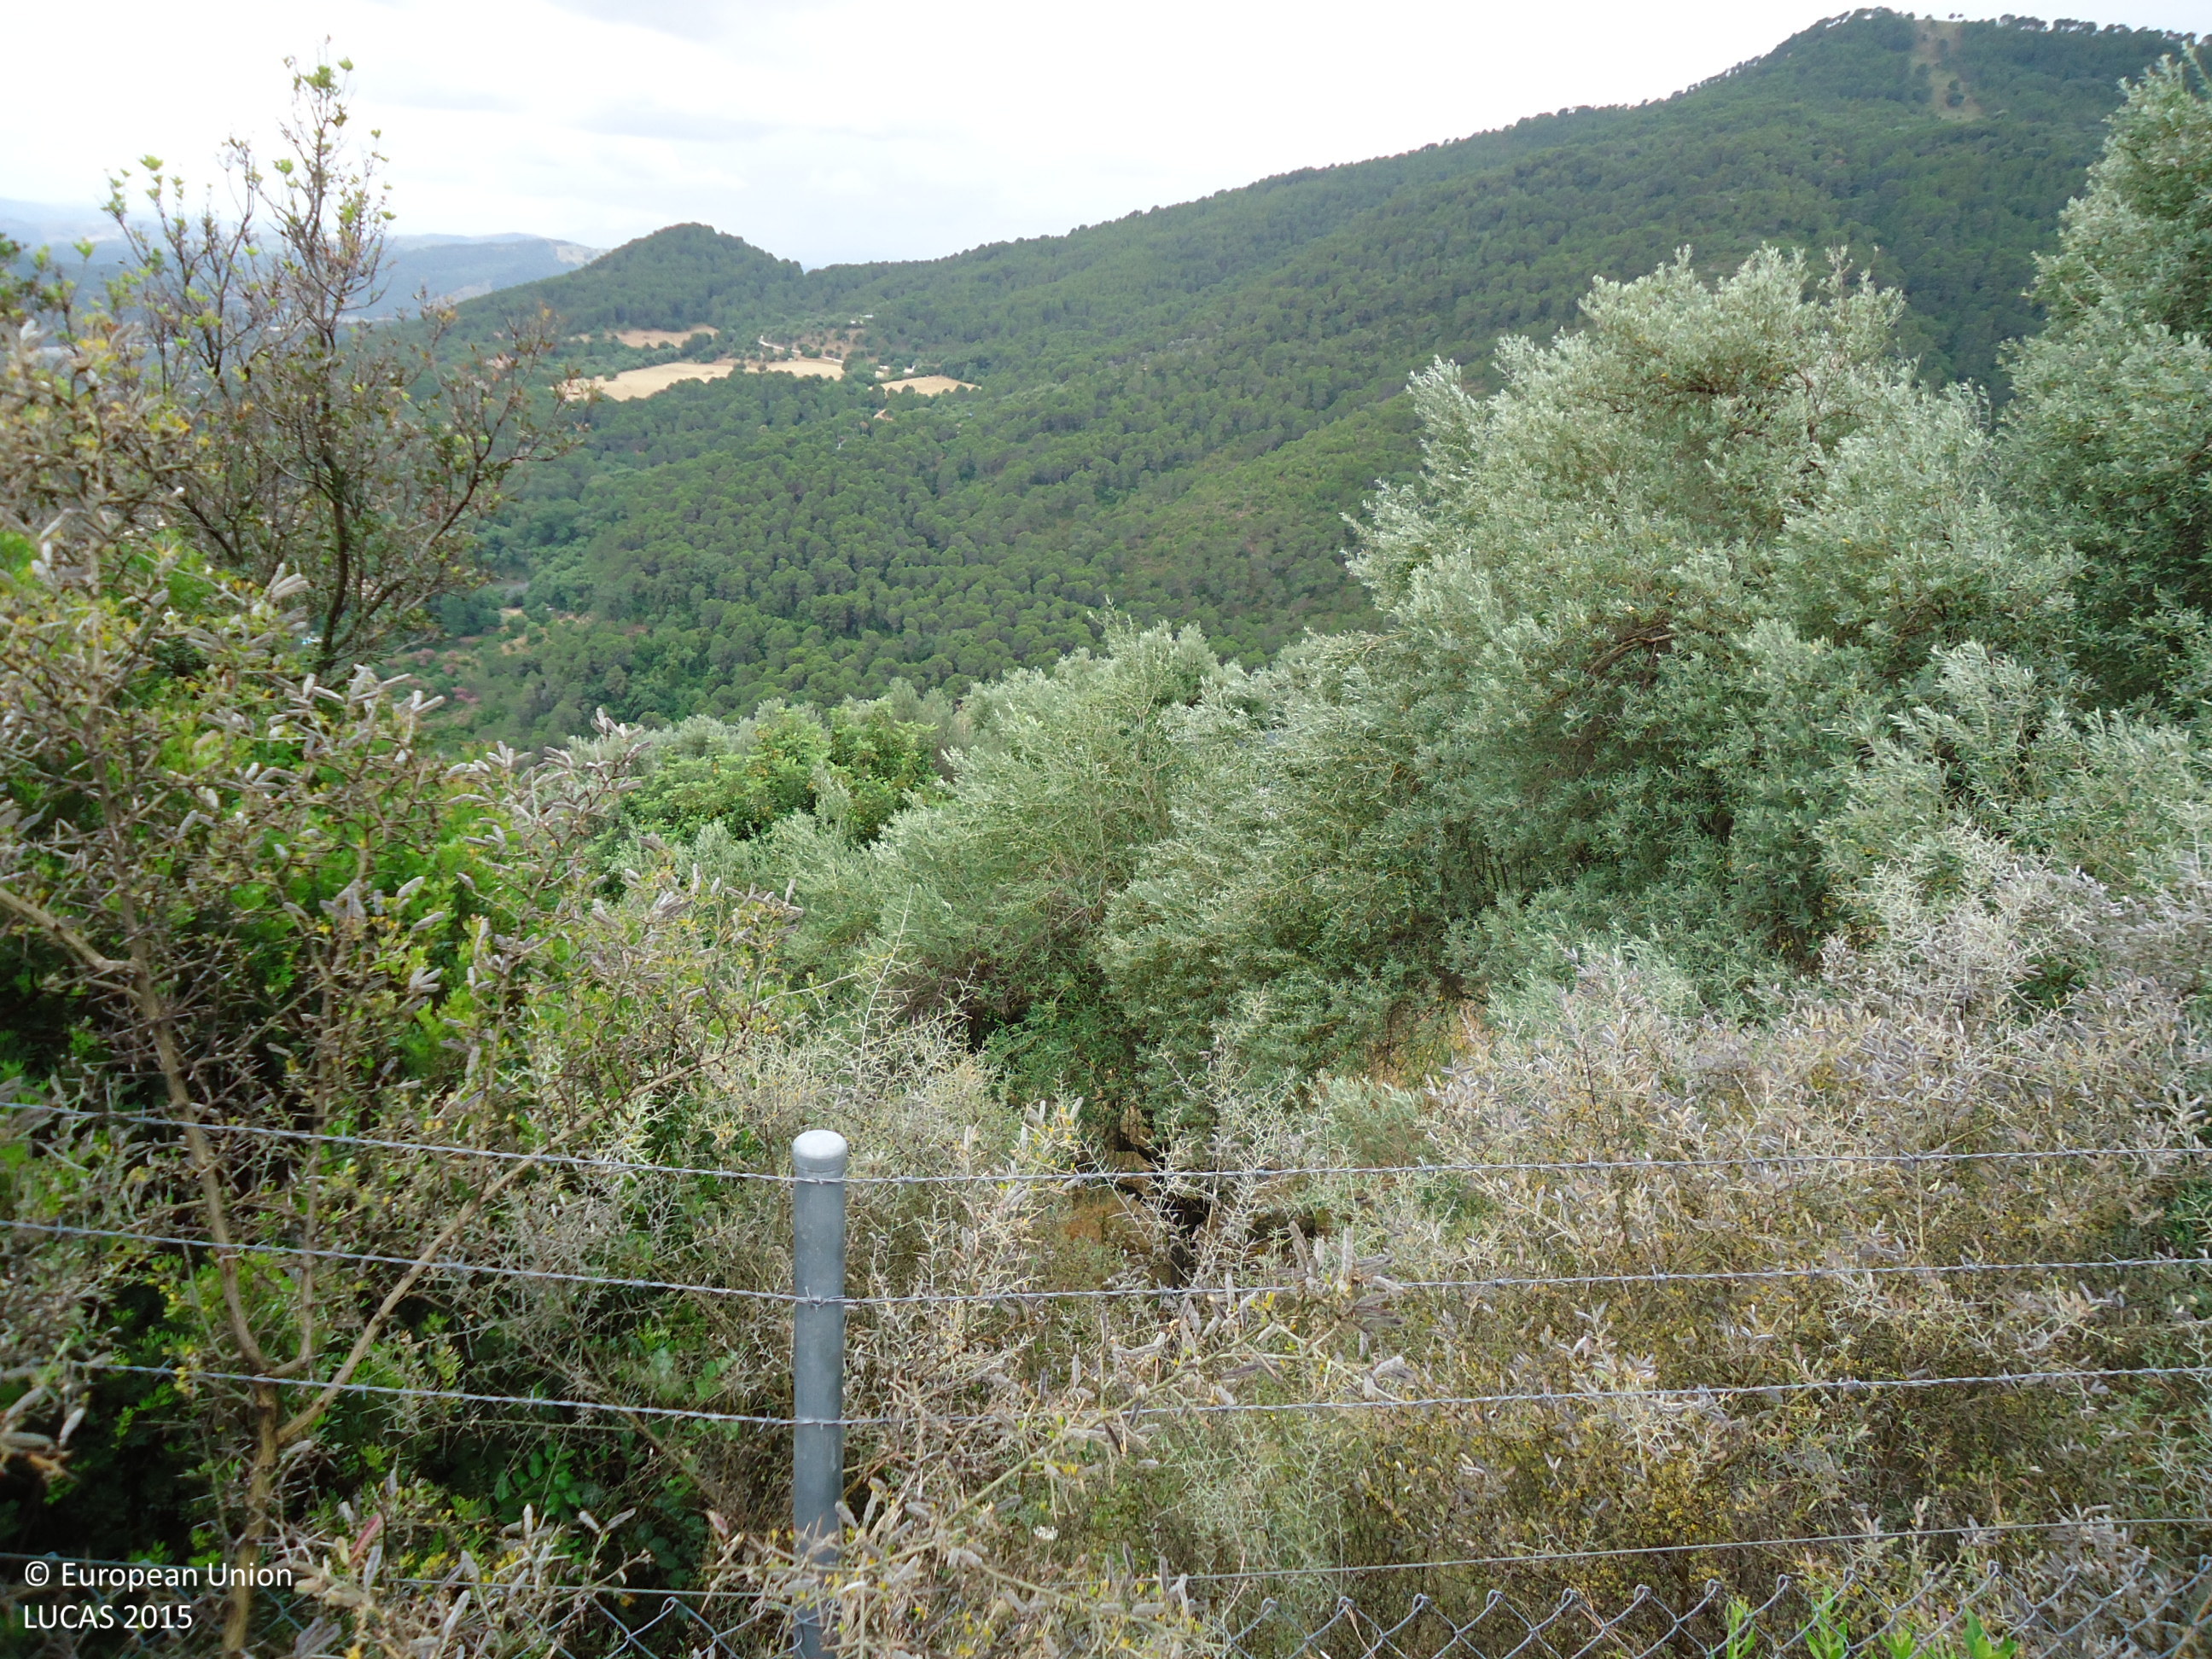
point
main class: Woodland
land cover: Broadleaved woodland
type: broadleaved evergreen forest
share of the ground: 25 - 50 %
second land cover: Grassland without tree/shrub cover
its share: > 75 %
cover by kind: herbaceous plants 55 %, broadleaved forest trees 45 %
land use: Forestry
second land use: Agriculture (excluding fallow land and kitchen gardens)
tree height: > 5 m
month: June
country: ES
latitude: 36.4974
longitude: -5.3248
